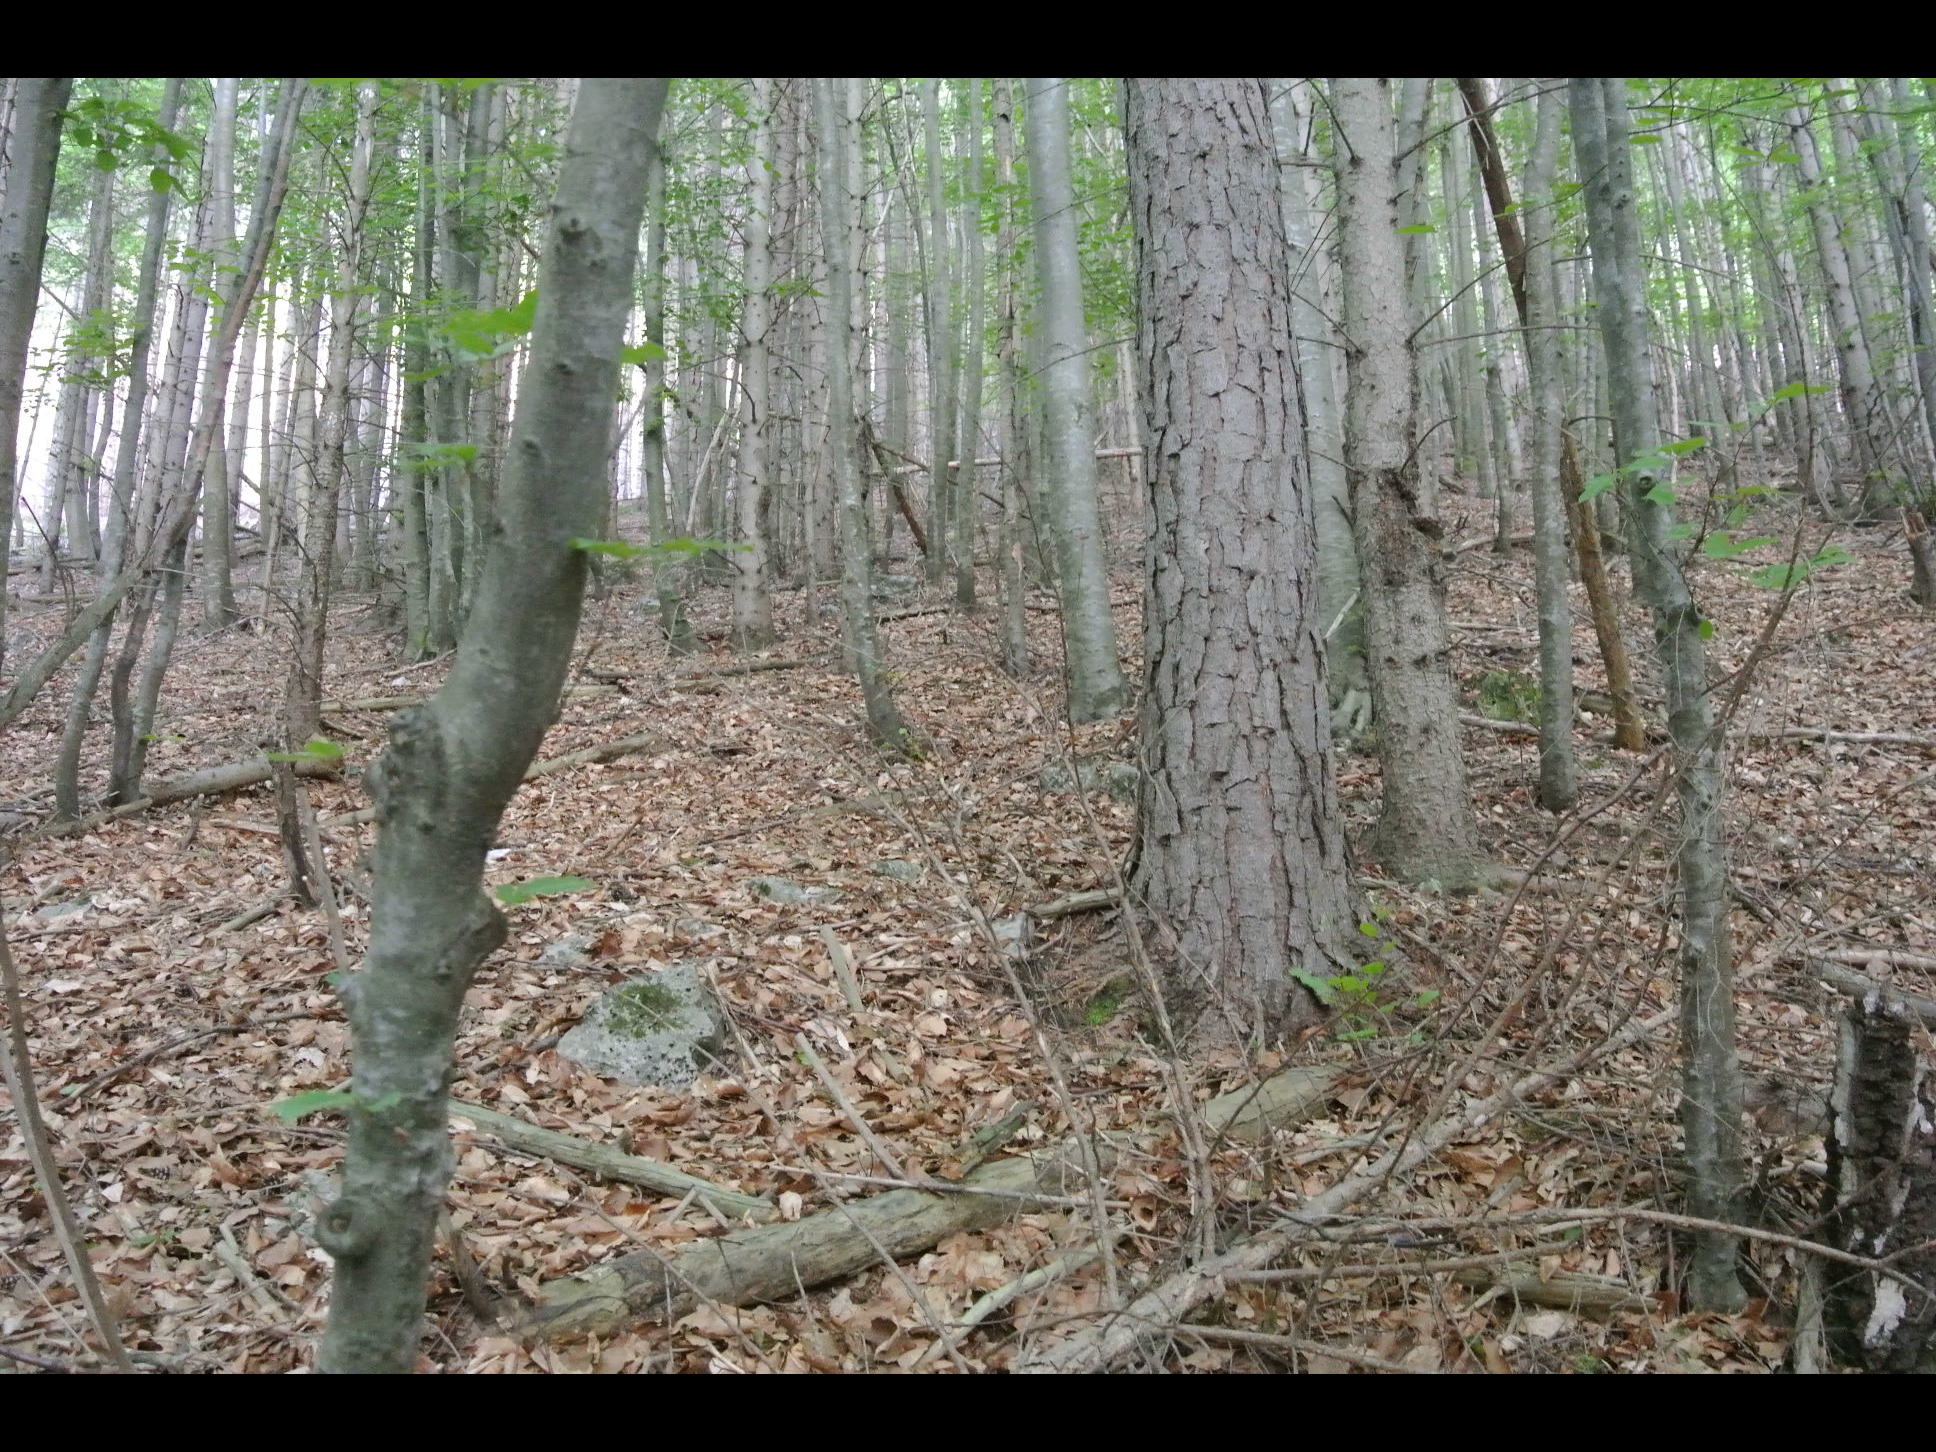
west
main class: Woodland
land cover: Broadleaved woodland
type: beech forest
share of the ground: > 75 %
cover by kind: broadleaved forest trees 100 %
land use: Forestry
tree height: > 5 m
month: May
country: AT
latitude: 47.7100
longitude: 15.7999
